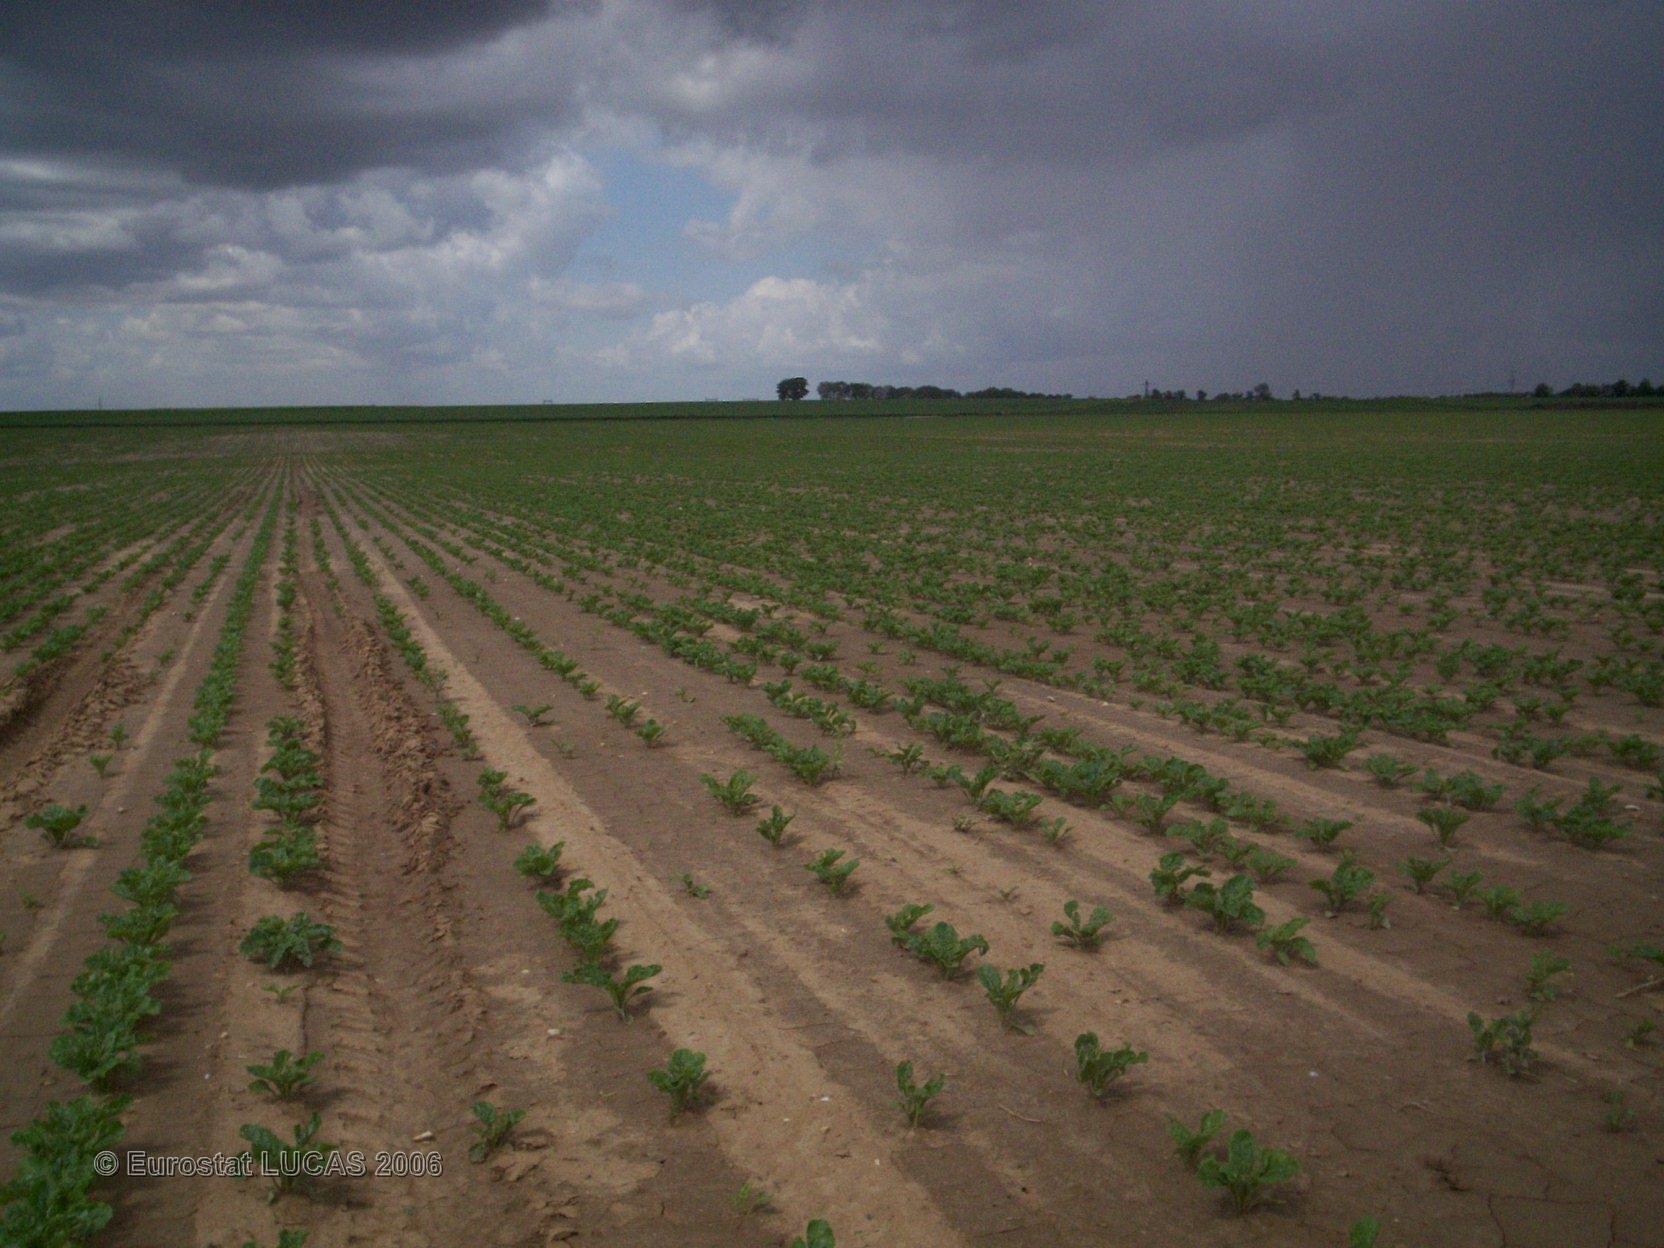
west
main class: Cropland
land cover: Sugar beet
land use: Agriculture (excluding fallow land and kitchen gardens)
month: May
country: FR
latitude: 48.9611
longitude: 2.7648
